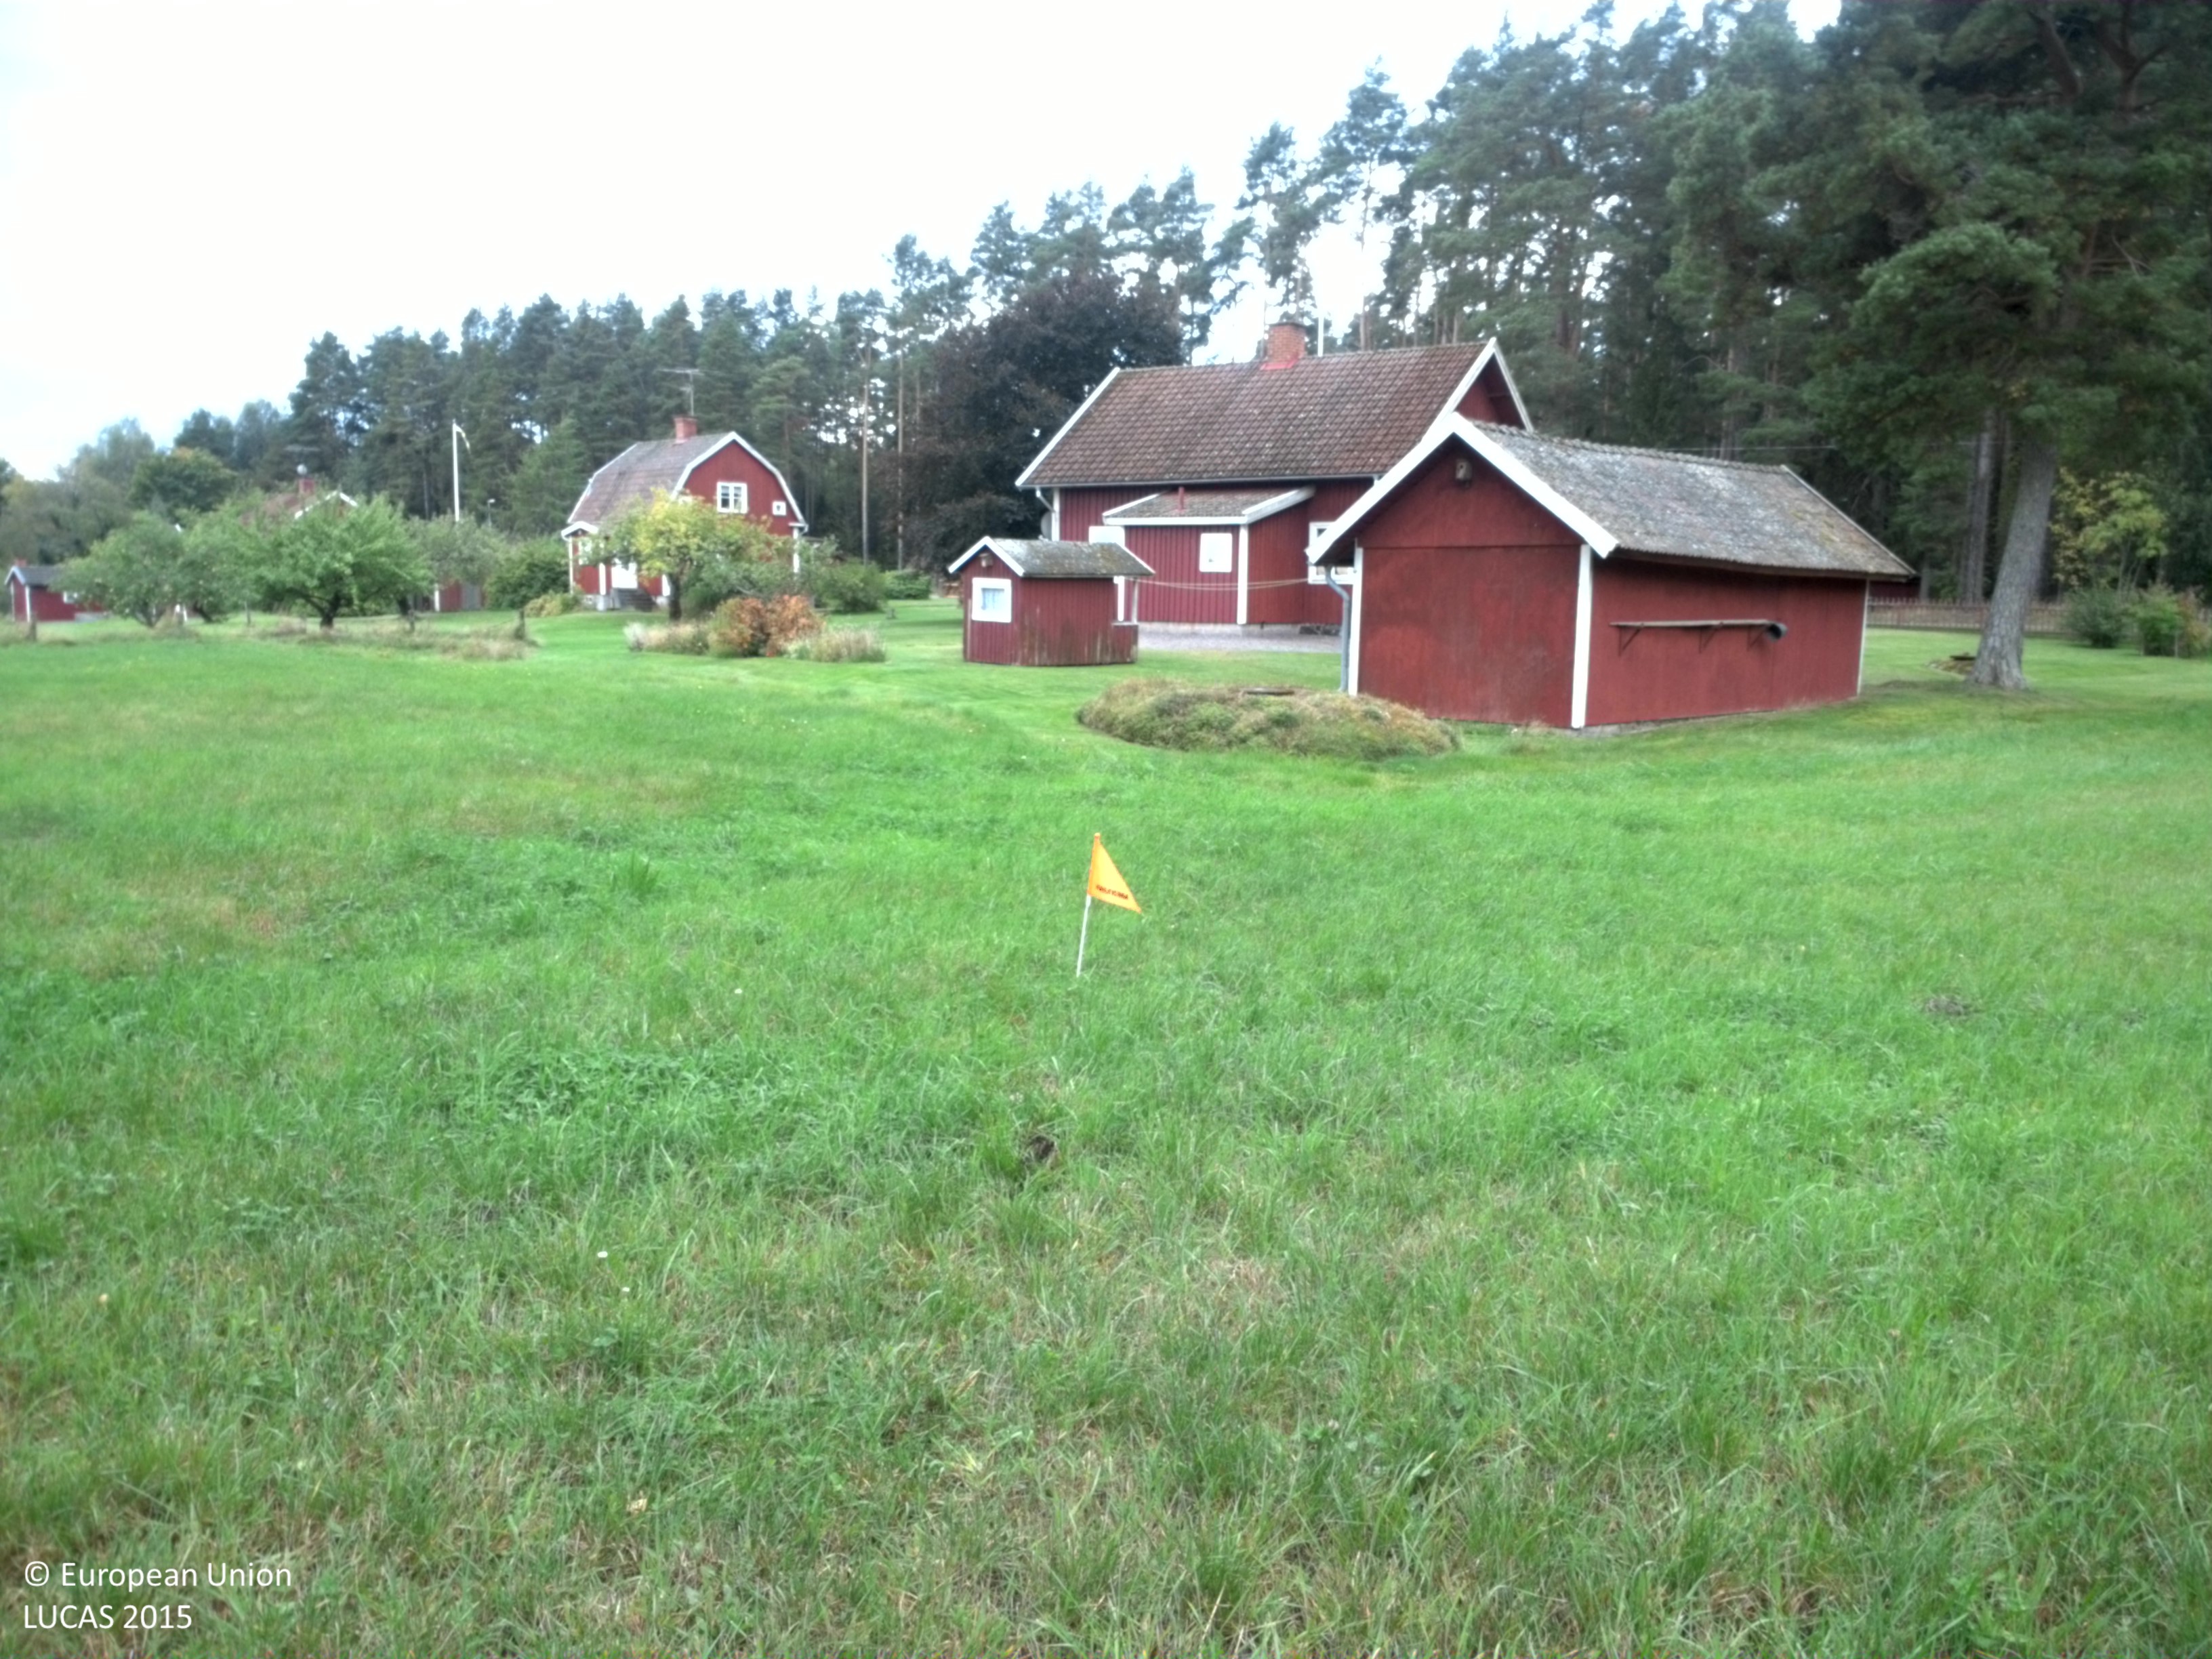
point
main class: Cropland
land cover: Temporary grasslands
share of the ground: > 75 %
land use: Agriculture (excluding fallow land and kitchen gardens)
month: September
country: SE
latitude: 59.0042
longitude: 14.0837
